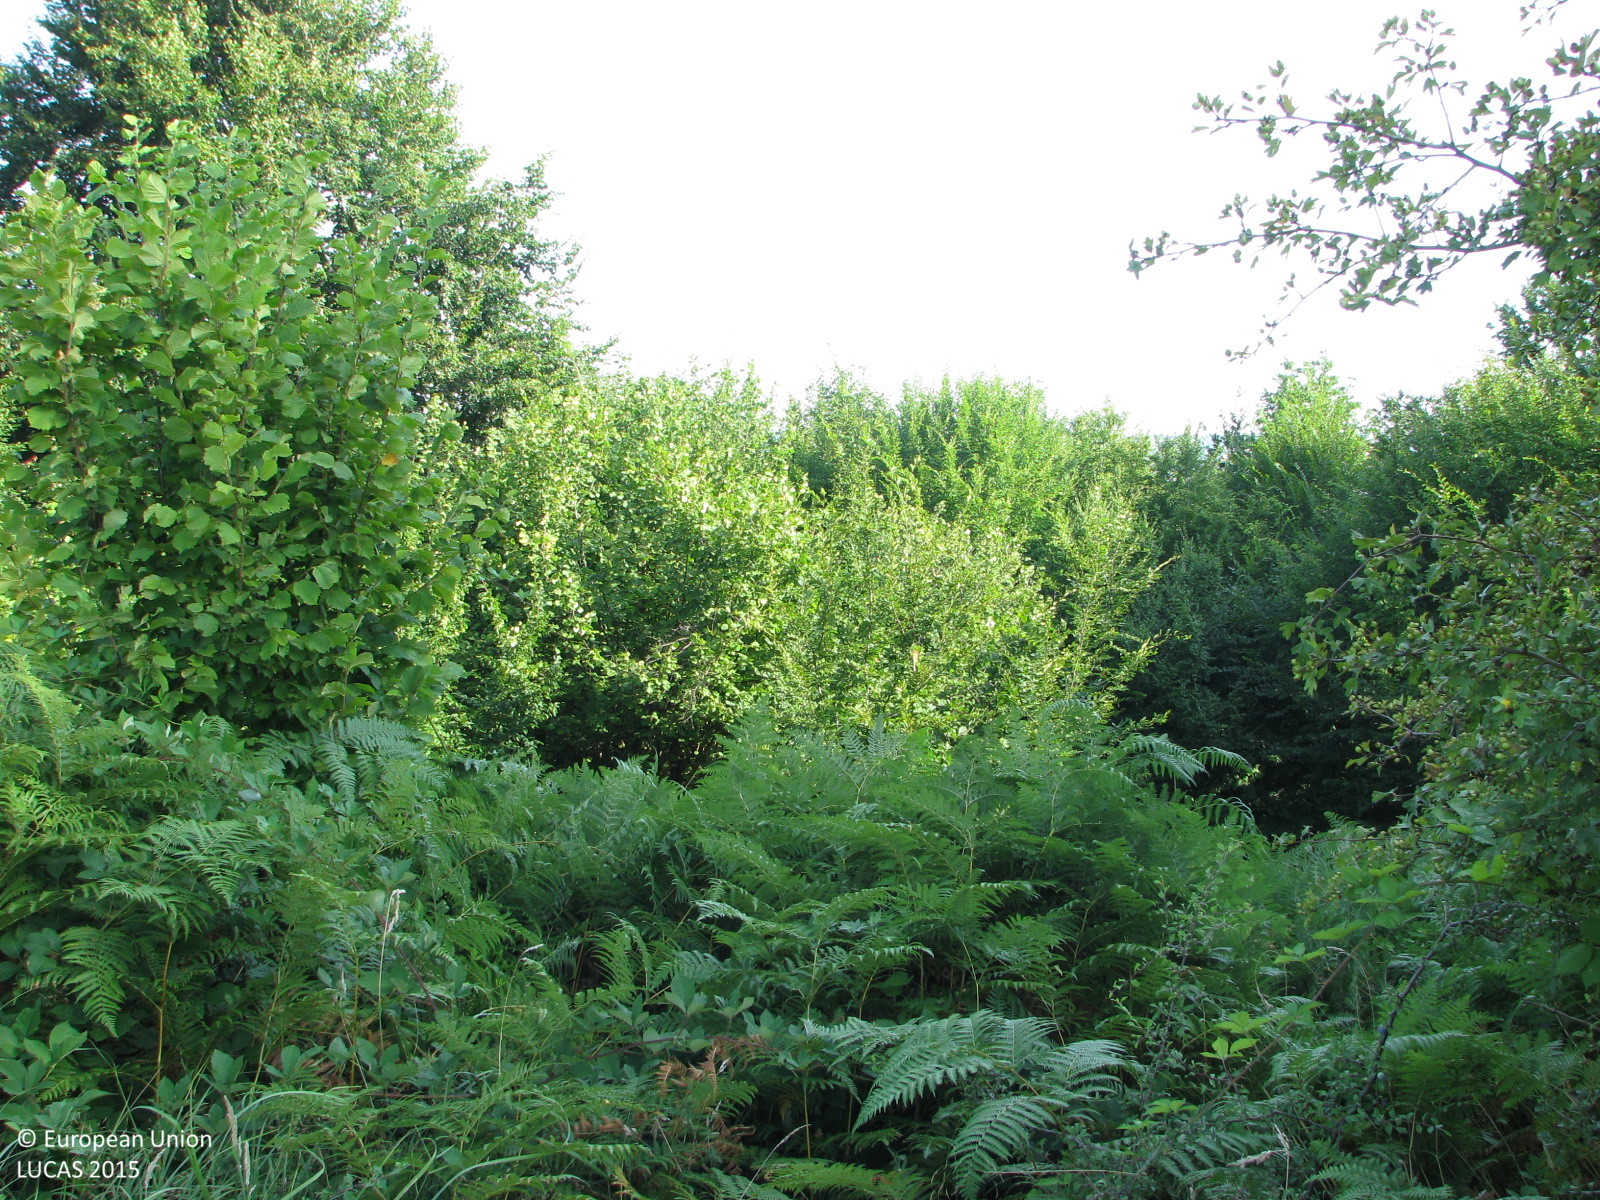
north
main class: Shrubland
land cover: Shrubland without tree cover
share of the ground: 25 - 50 %
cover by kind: herbaceous plants 55 %, shrubs 45 %
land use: Forestry
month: August
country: BG
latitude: 42.8851
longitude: 26.1907
